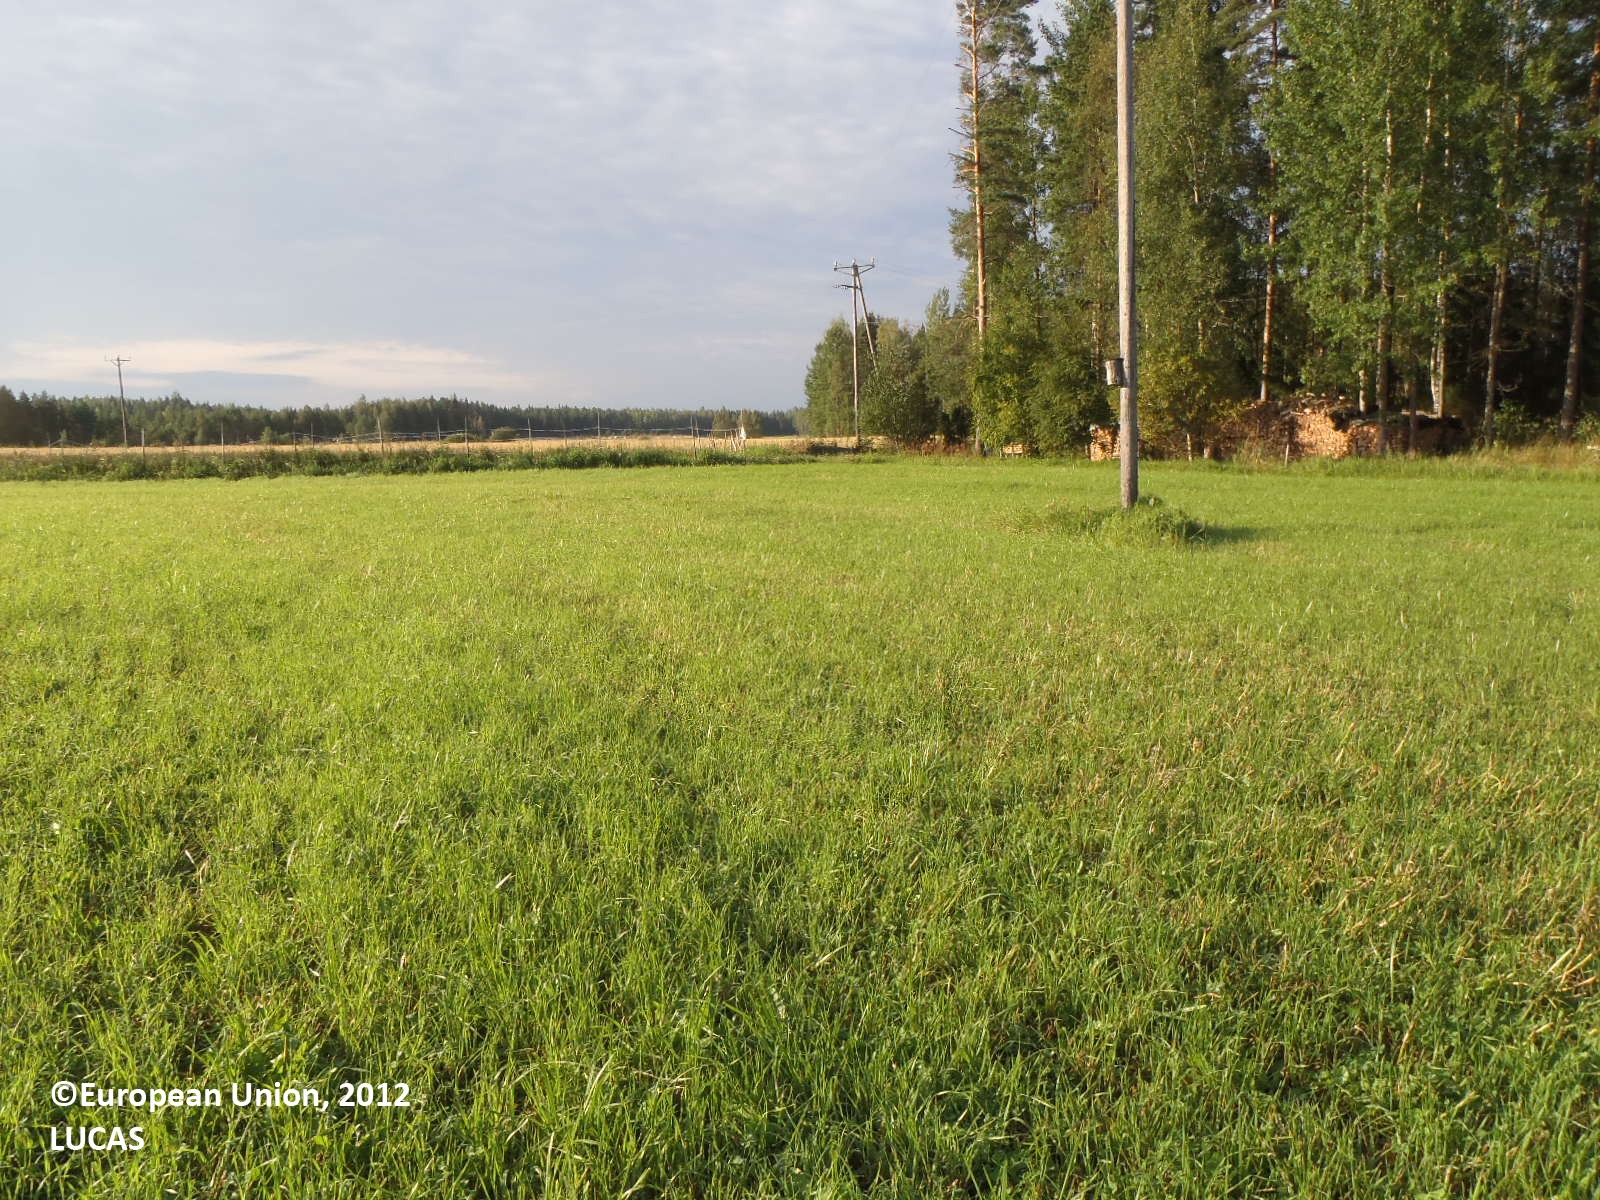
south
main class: Cropland
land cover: Temporary grasslands
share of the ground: > 75 %
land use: Agriculture (excluding fallow land and kitchen gardens)
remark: Harvested field
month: August
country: FI
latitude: 60.8081
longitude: 22.5117
